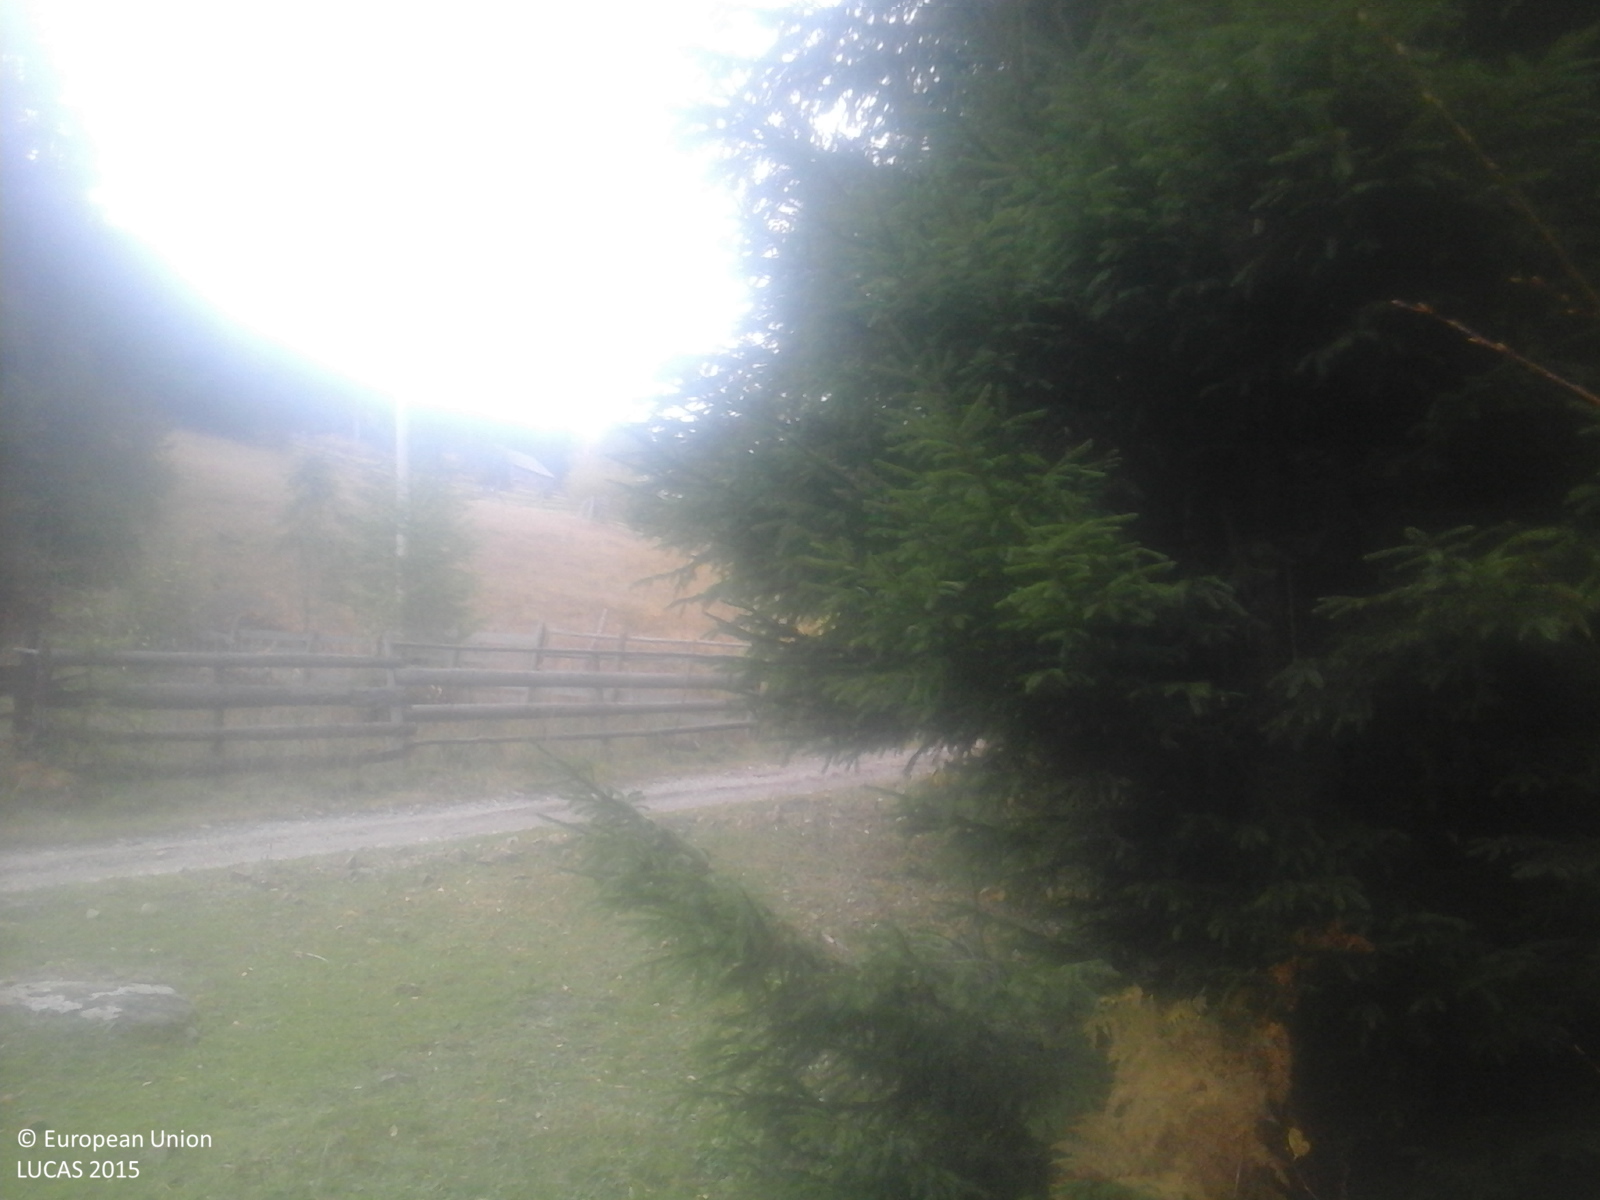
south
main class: Woodland
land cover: Spruce dominated coniferous woodland
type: alpine coniferous forest
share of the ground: 50 - 75 %
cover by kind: coniferous forest trees 60 %, herbaceous plants 40 %
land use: Forestry
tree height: > 5 m
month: October
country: RO
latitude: 47.2082
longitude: 25.3865
